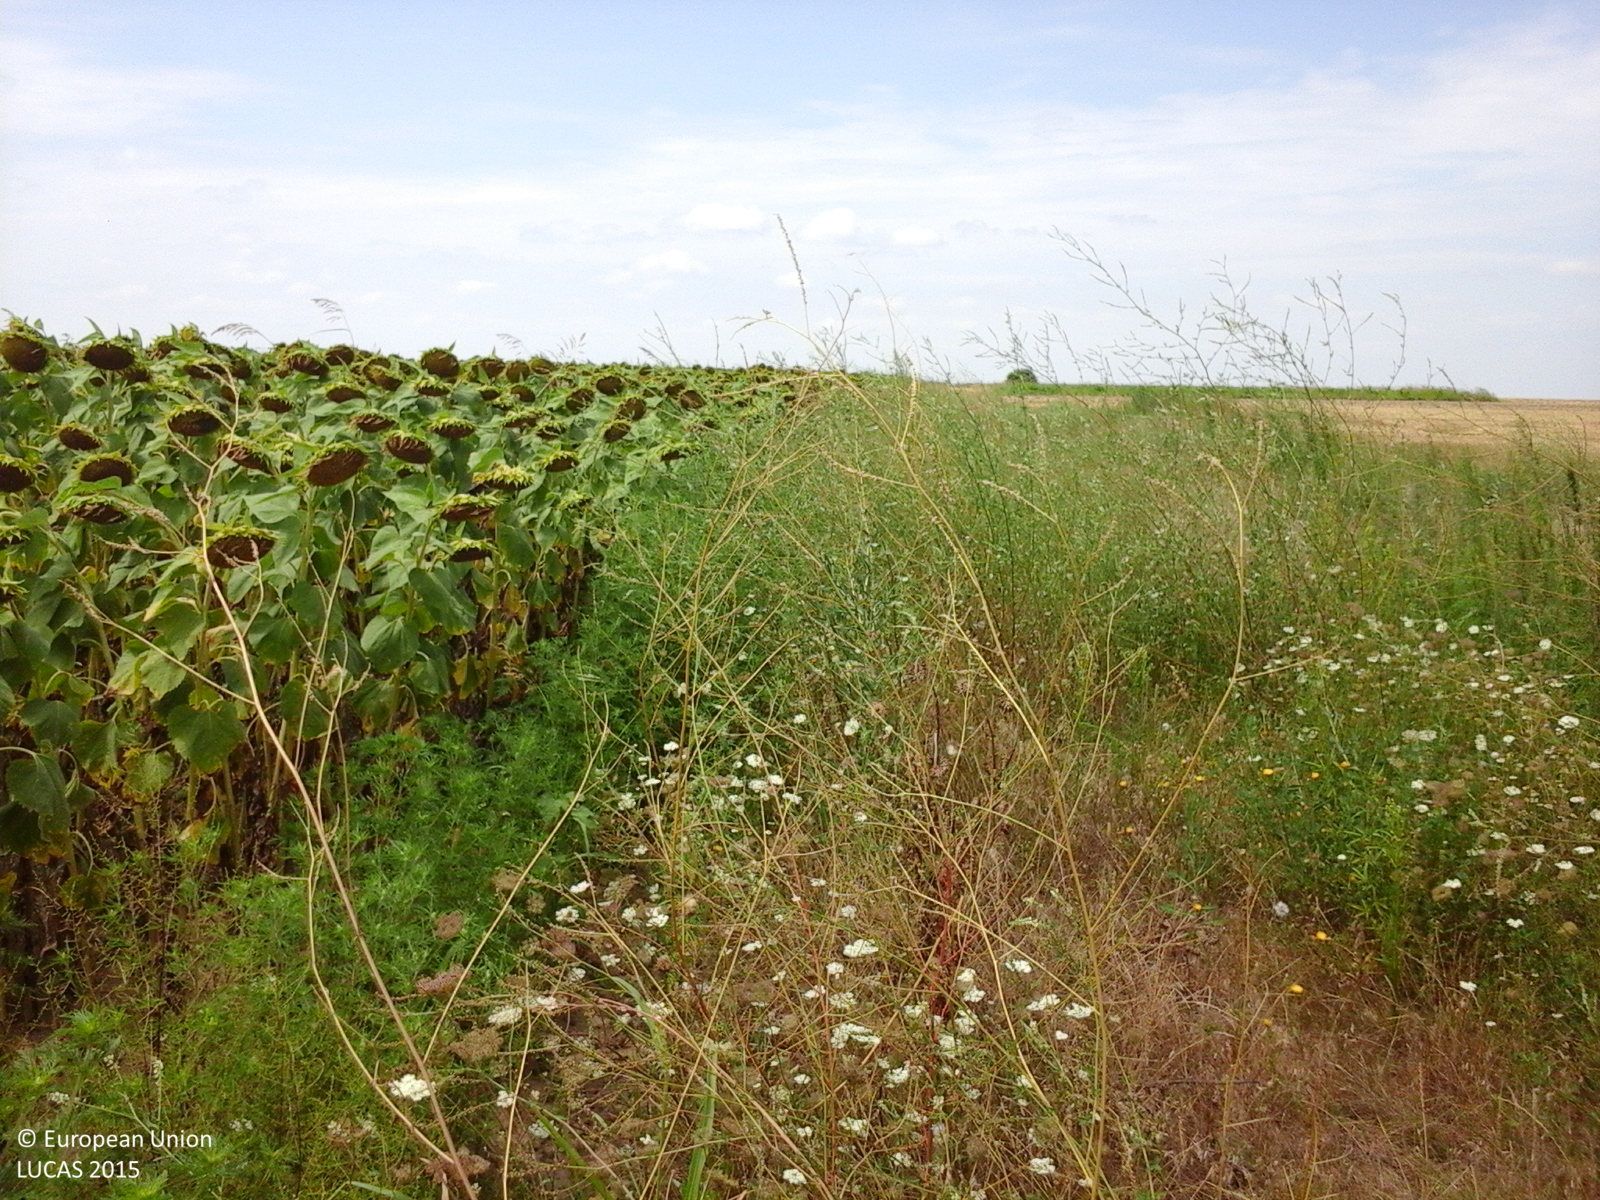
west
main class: Cropland
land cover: Sunflower
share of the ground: > 75 %
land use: Agriculture (excluding fallow land and kitchen gardens)
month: August
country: RO
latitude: 44.7815
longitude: 28.1496
